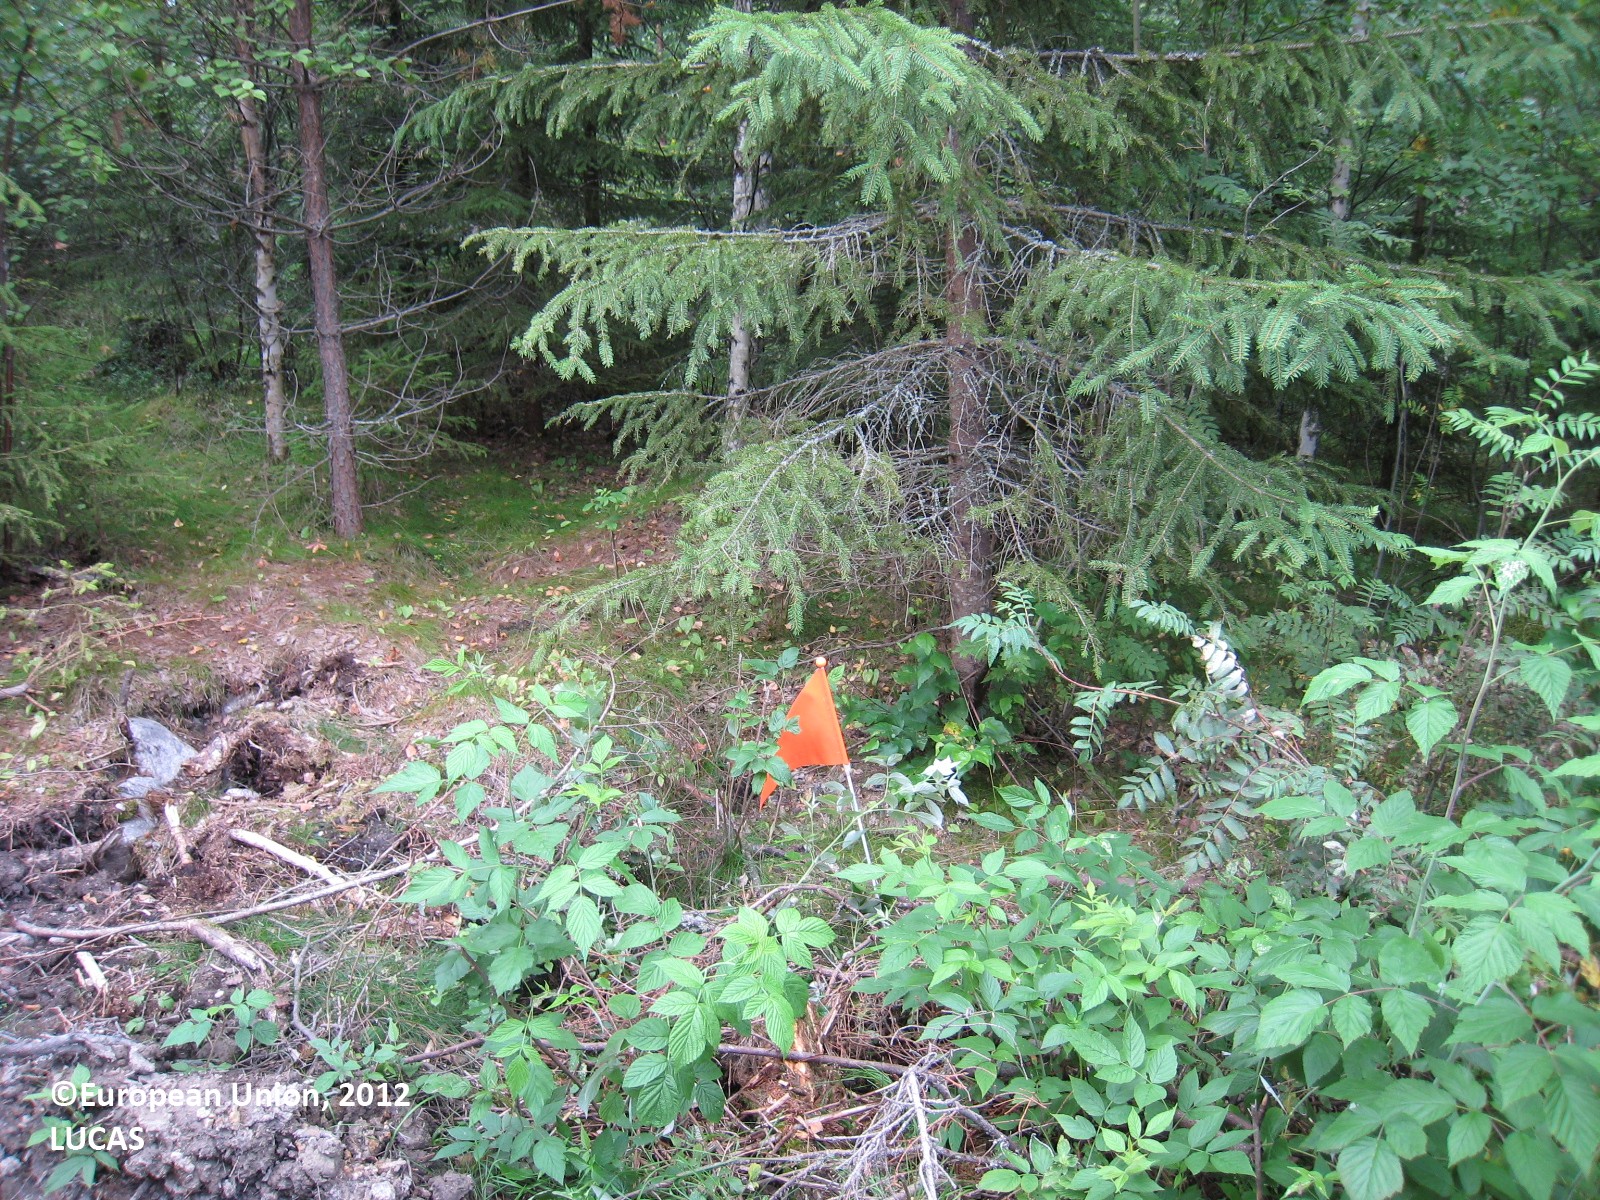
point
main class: Woodland
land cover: Other mixed woodland
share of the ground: > 75 %
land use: Forestry
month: July
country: FI
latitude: 61.7459
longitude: 26.0196
